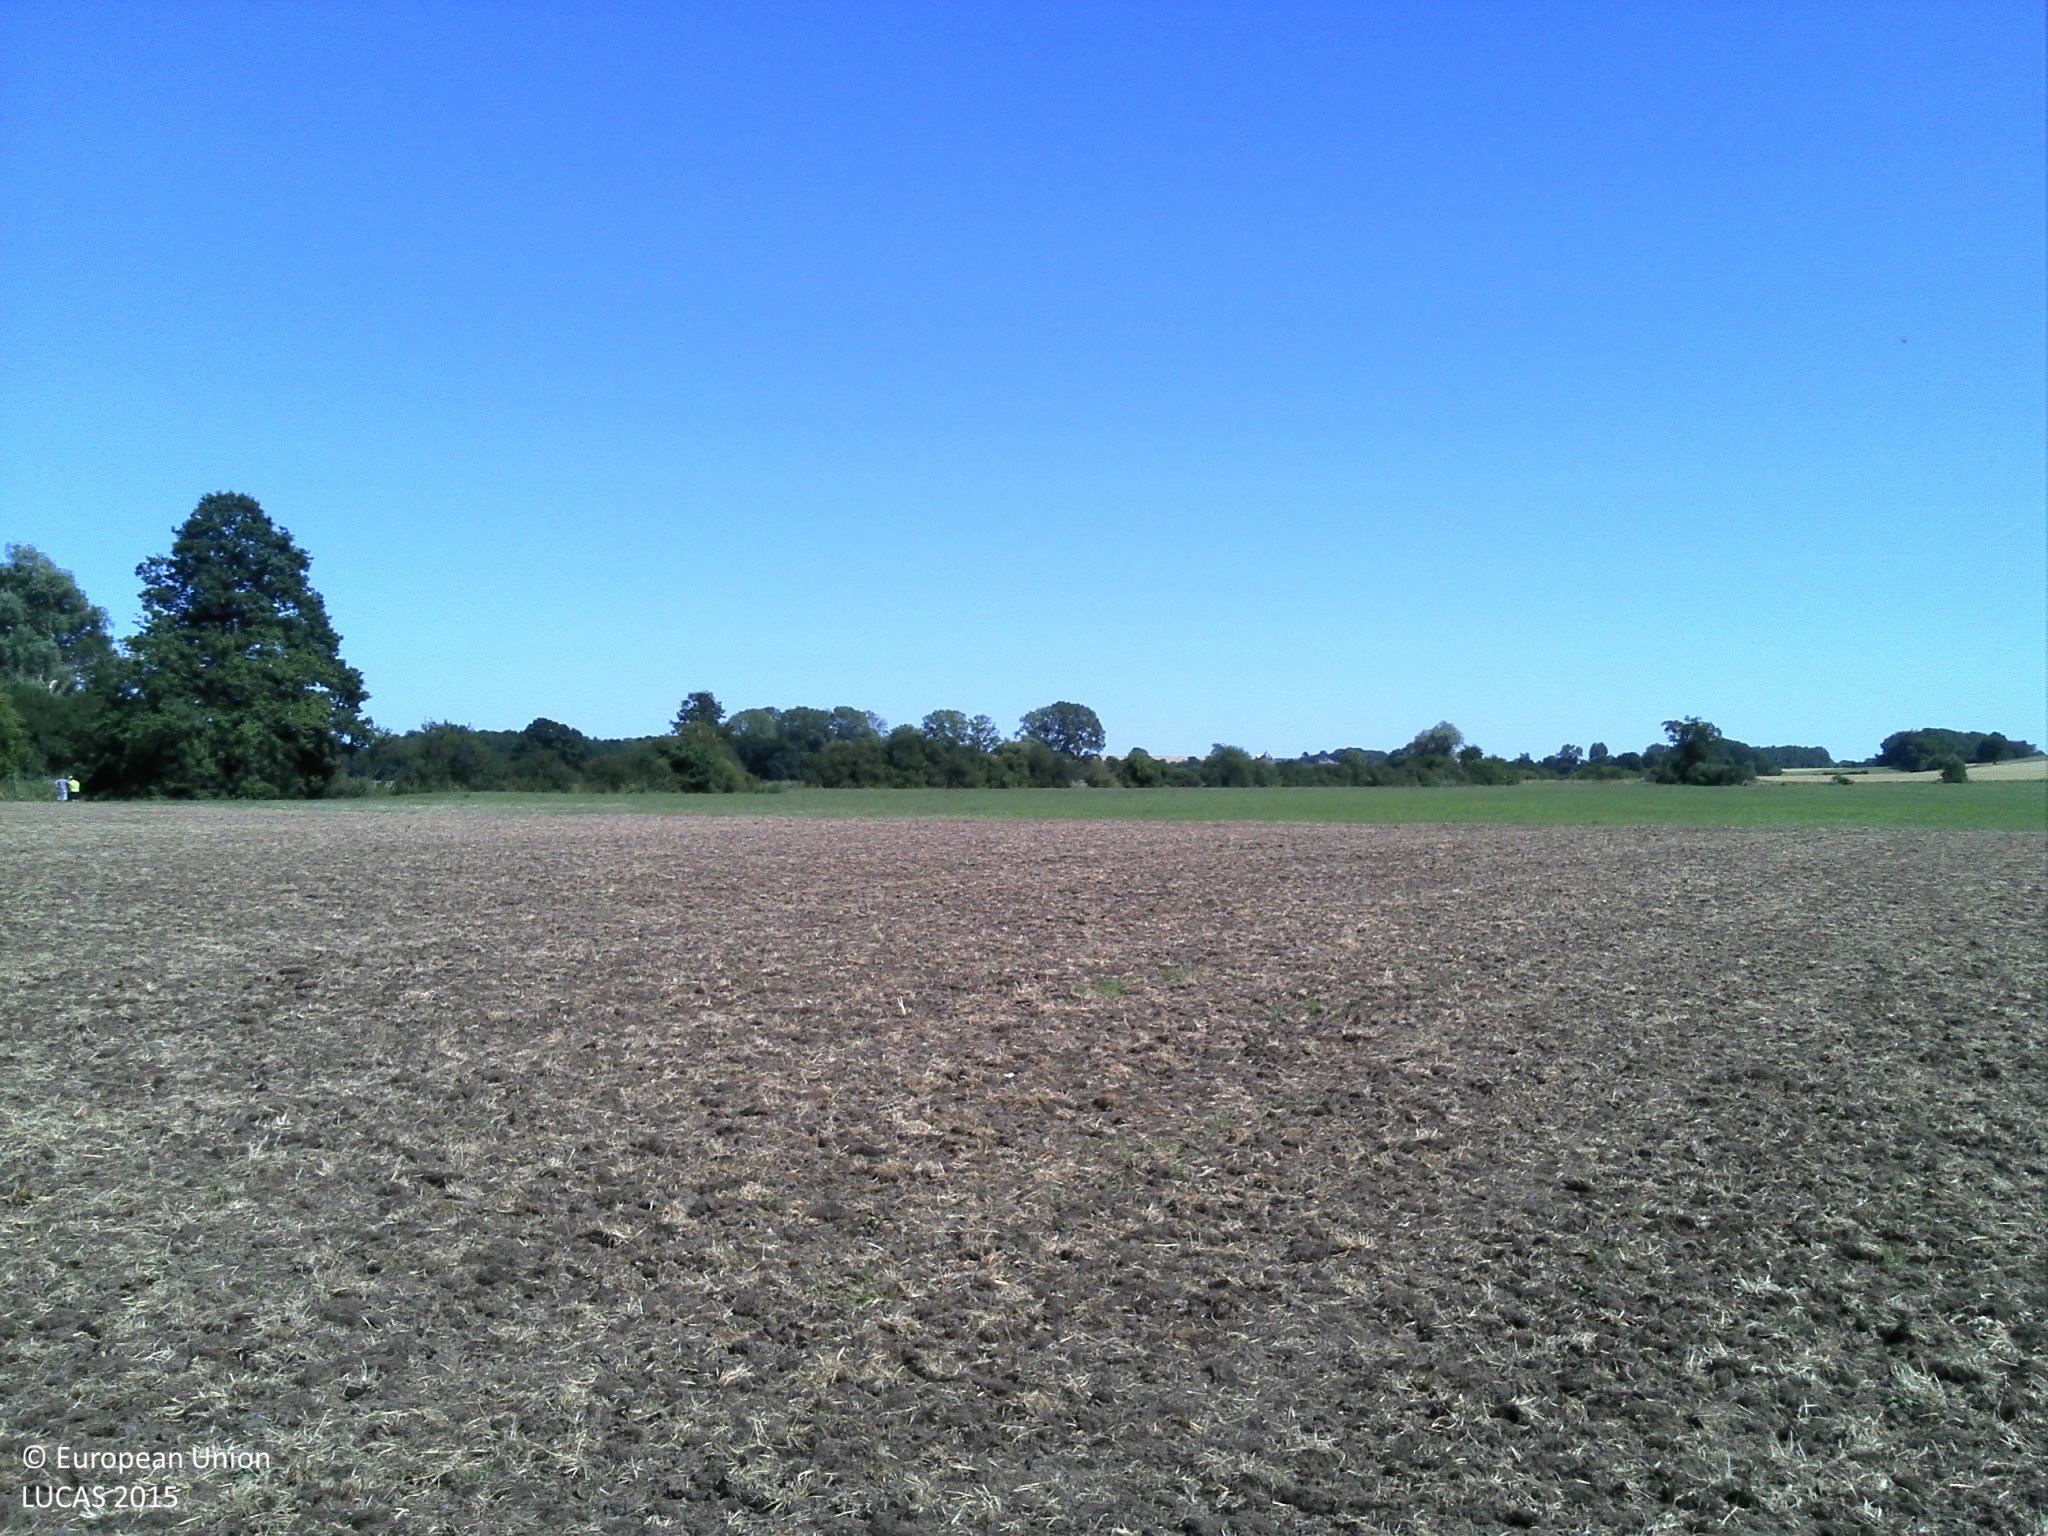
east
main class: Grassland
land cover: Grassland without tree/shrub cover
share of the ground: > 75 %
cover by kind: herbaceous plants 100 %
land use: Agriculture (excluding fallow land and kitchen gardens)
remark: Tilled/Sowed
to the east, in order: Grassland without tree/shrub cover; Broadleaved woodland; Inland fresh running water; Abandoned hedges; Grassland without tree/shrub cover
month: July
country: FR
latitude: 49.4899
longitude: 4.8202
